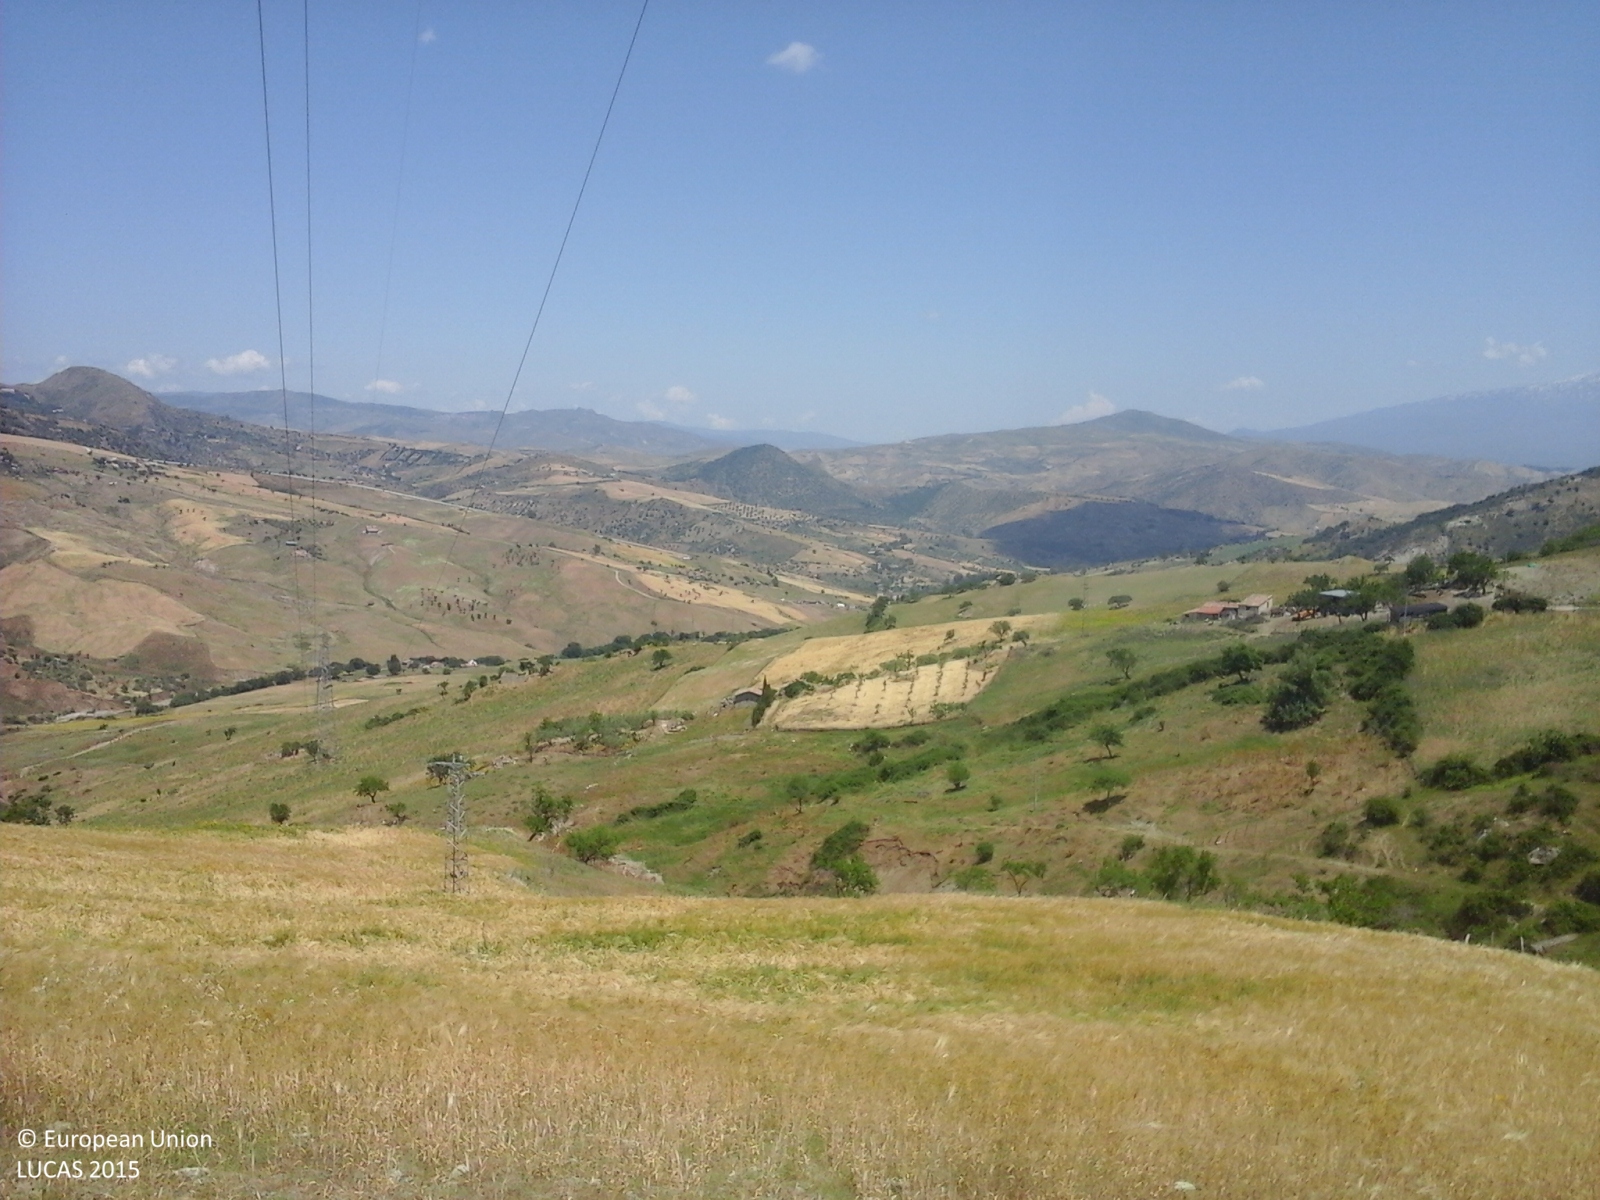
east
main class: Grassland
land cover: Grassland with sparse tree/shrub cover
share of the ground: > 75 %
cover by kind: herbaceous plants 90 %, broadleaved forest trees 5 %, shrubs 5 %
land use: Agriculture (excluding fallow land and kitchen gardens)
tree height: > 5 m
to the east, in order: Grassland with sparse tree/shrub cover; Abandoned hedges; Grassland without tree/shrub cover; Artificial constructions in urban areas; Shrubland with sparse tree cover; Durum wheat; Electric lines; Durum wheat; Single bushes/trees; Durum wheat
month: June
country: IT
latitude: 37.7459
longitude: 14.5866
